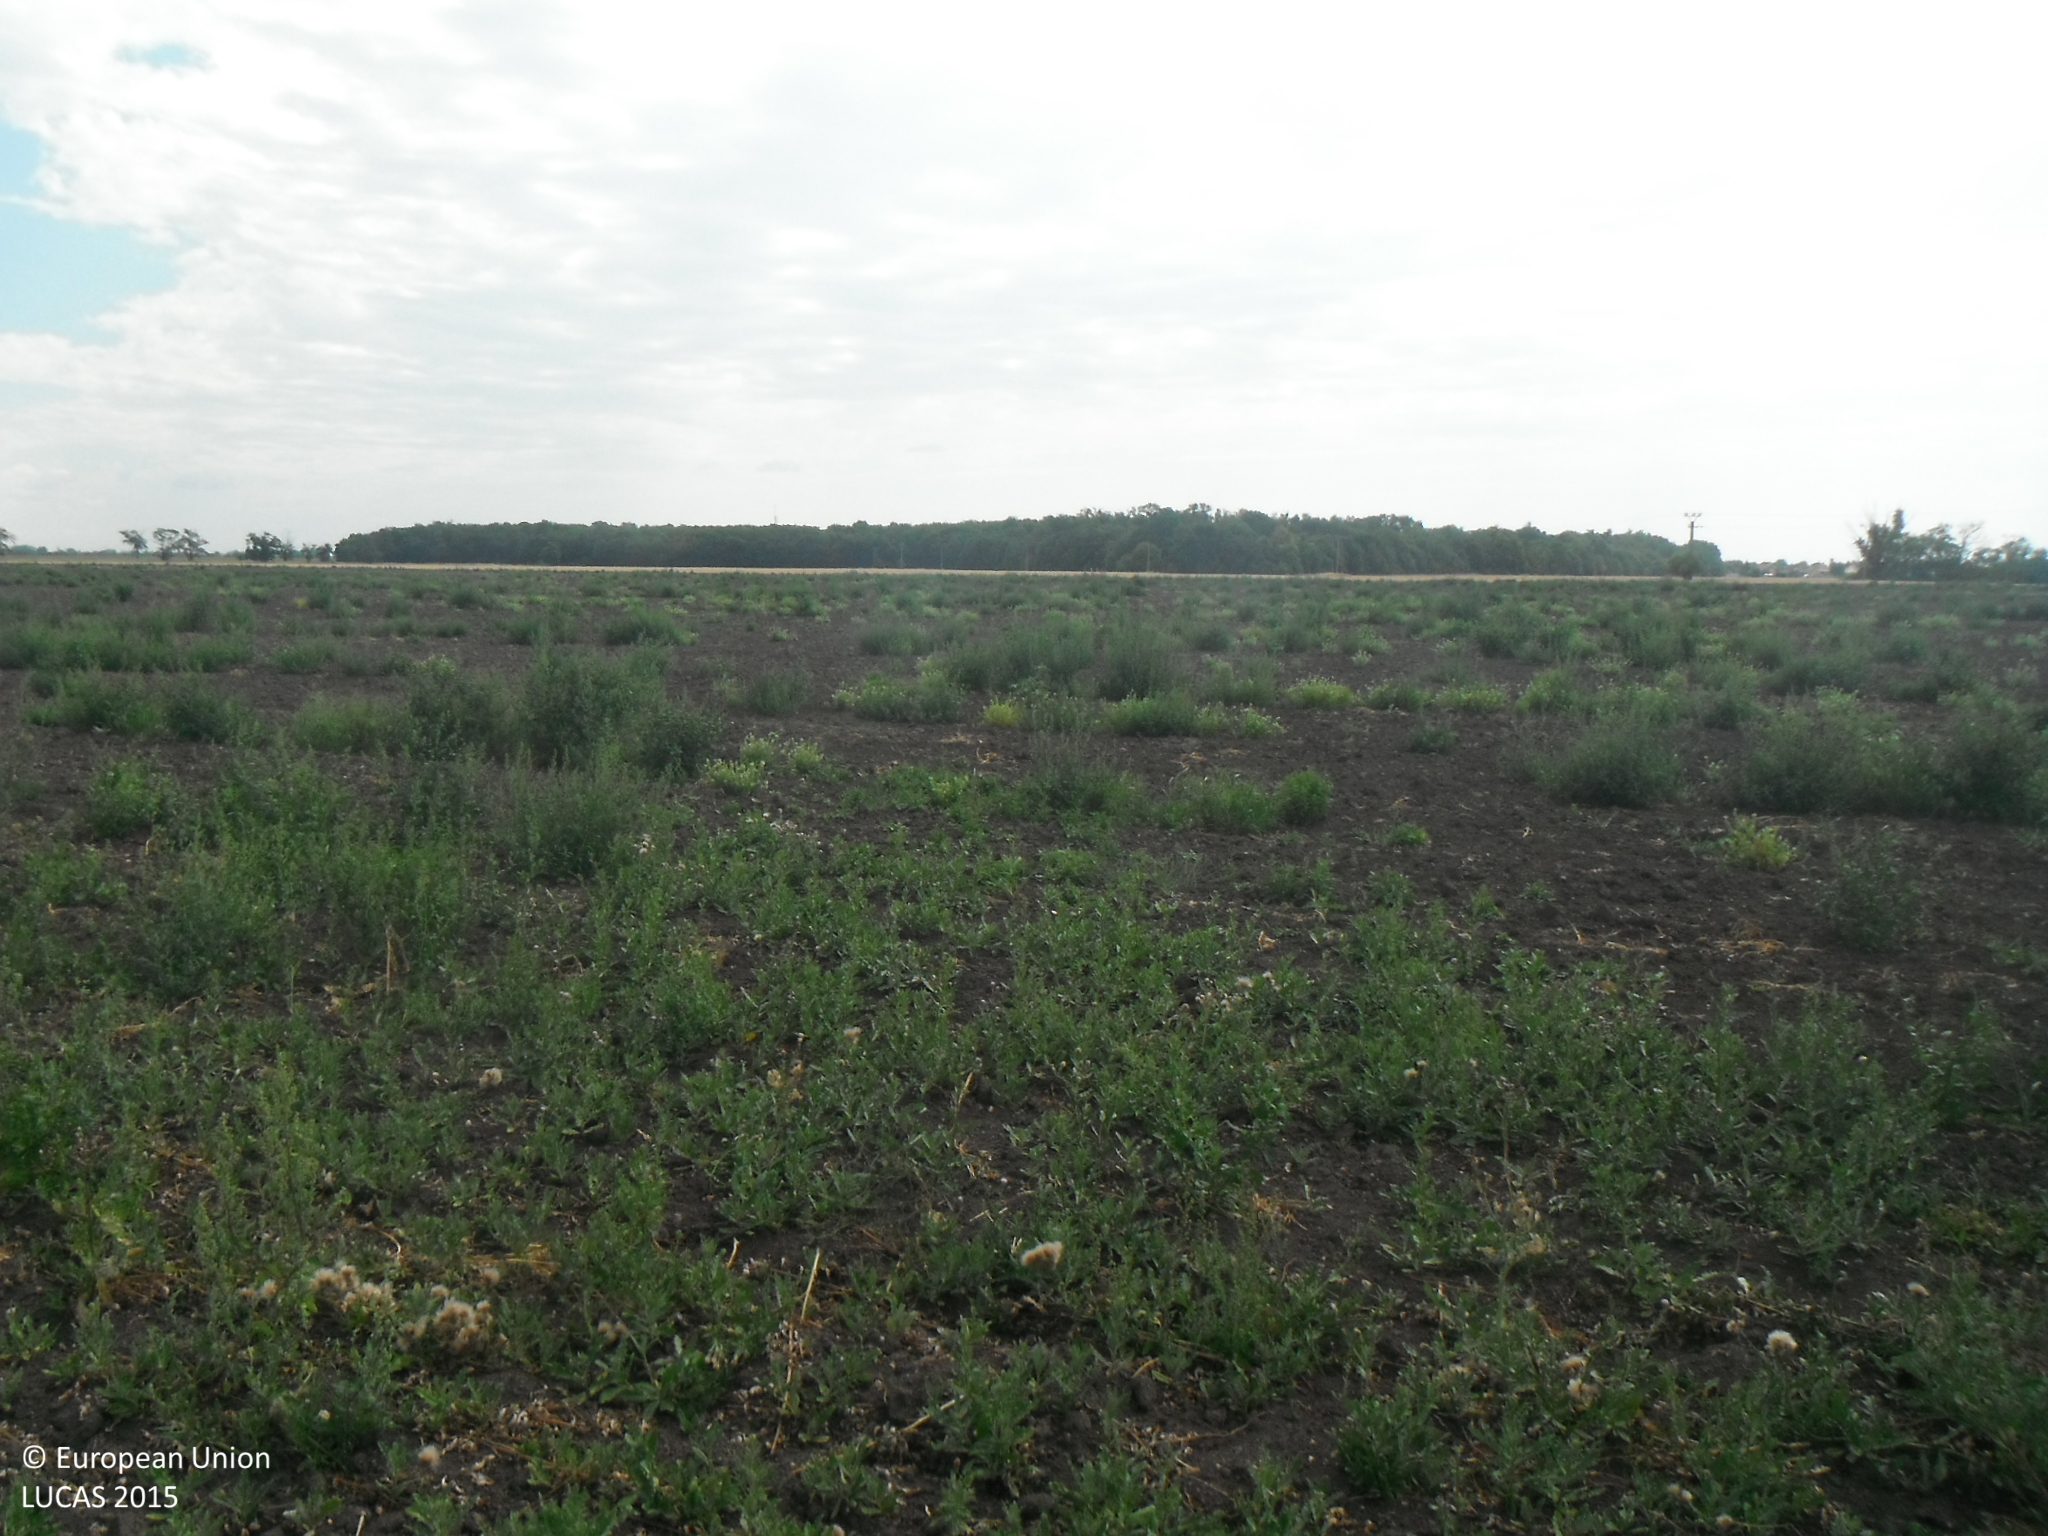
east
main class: Grassland
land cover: Spontaneously vegetated surfaces
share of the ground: 25 - 50 %
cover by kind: unconsolidated bare surface 65 %, herbaceous plants 35 %
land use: Fallow land
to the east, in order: Spontaneously vegetated surfaces; Barley
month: July
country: SK
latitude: 48.1024
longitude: 17.3817
